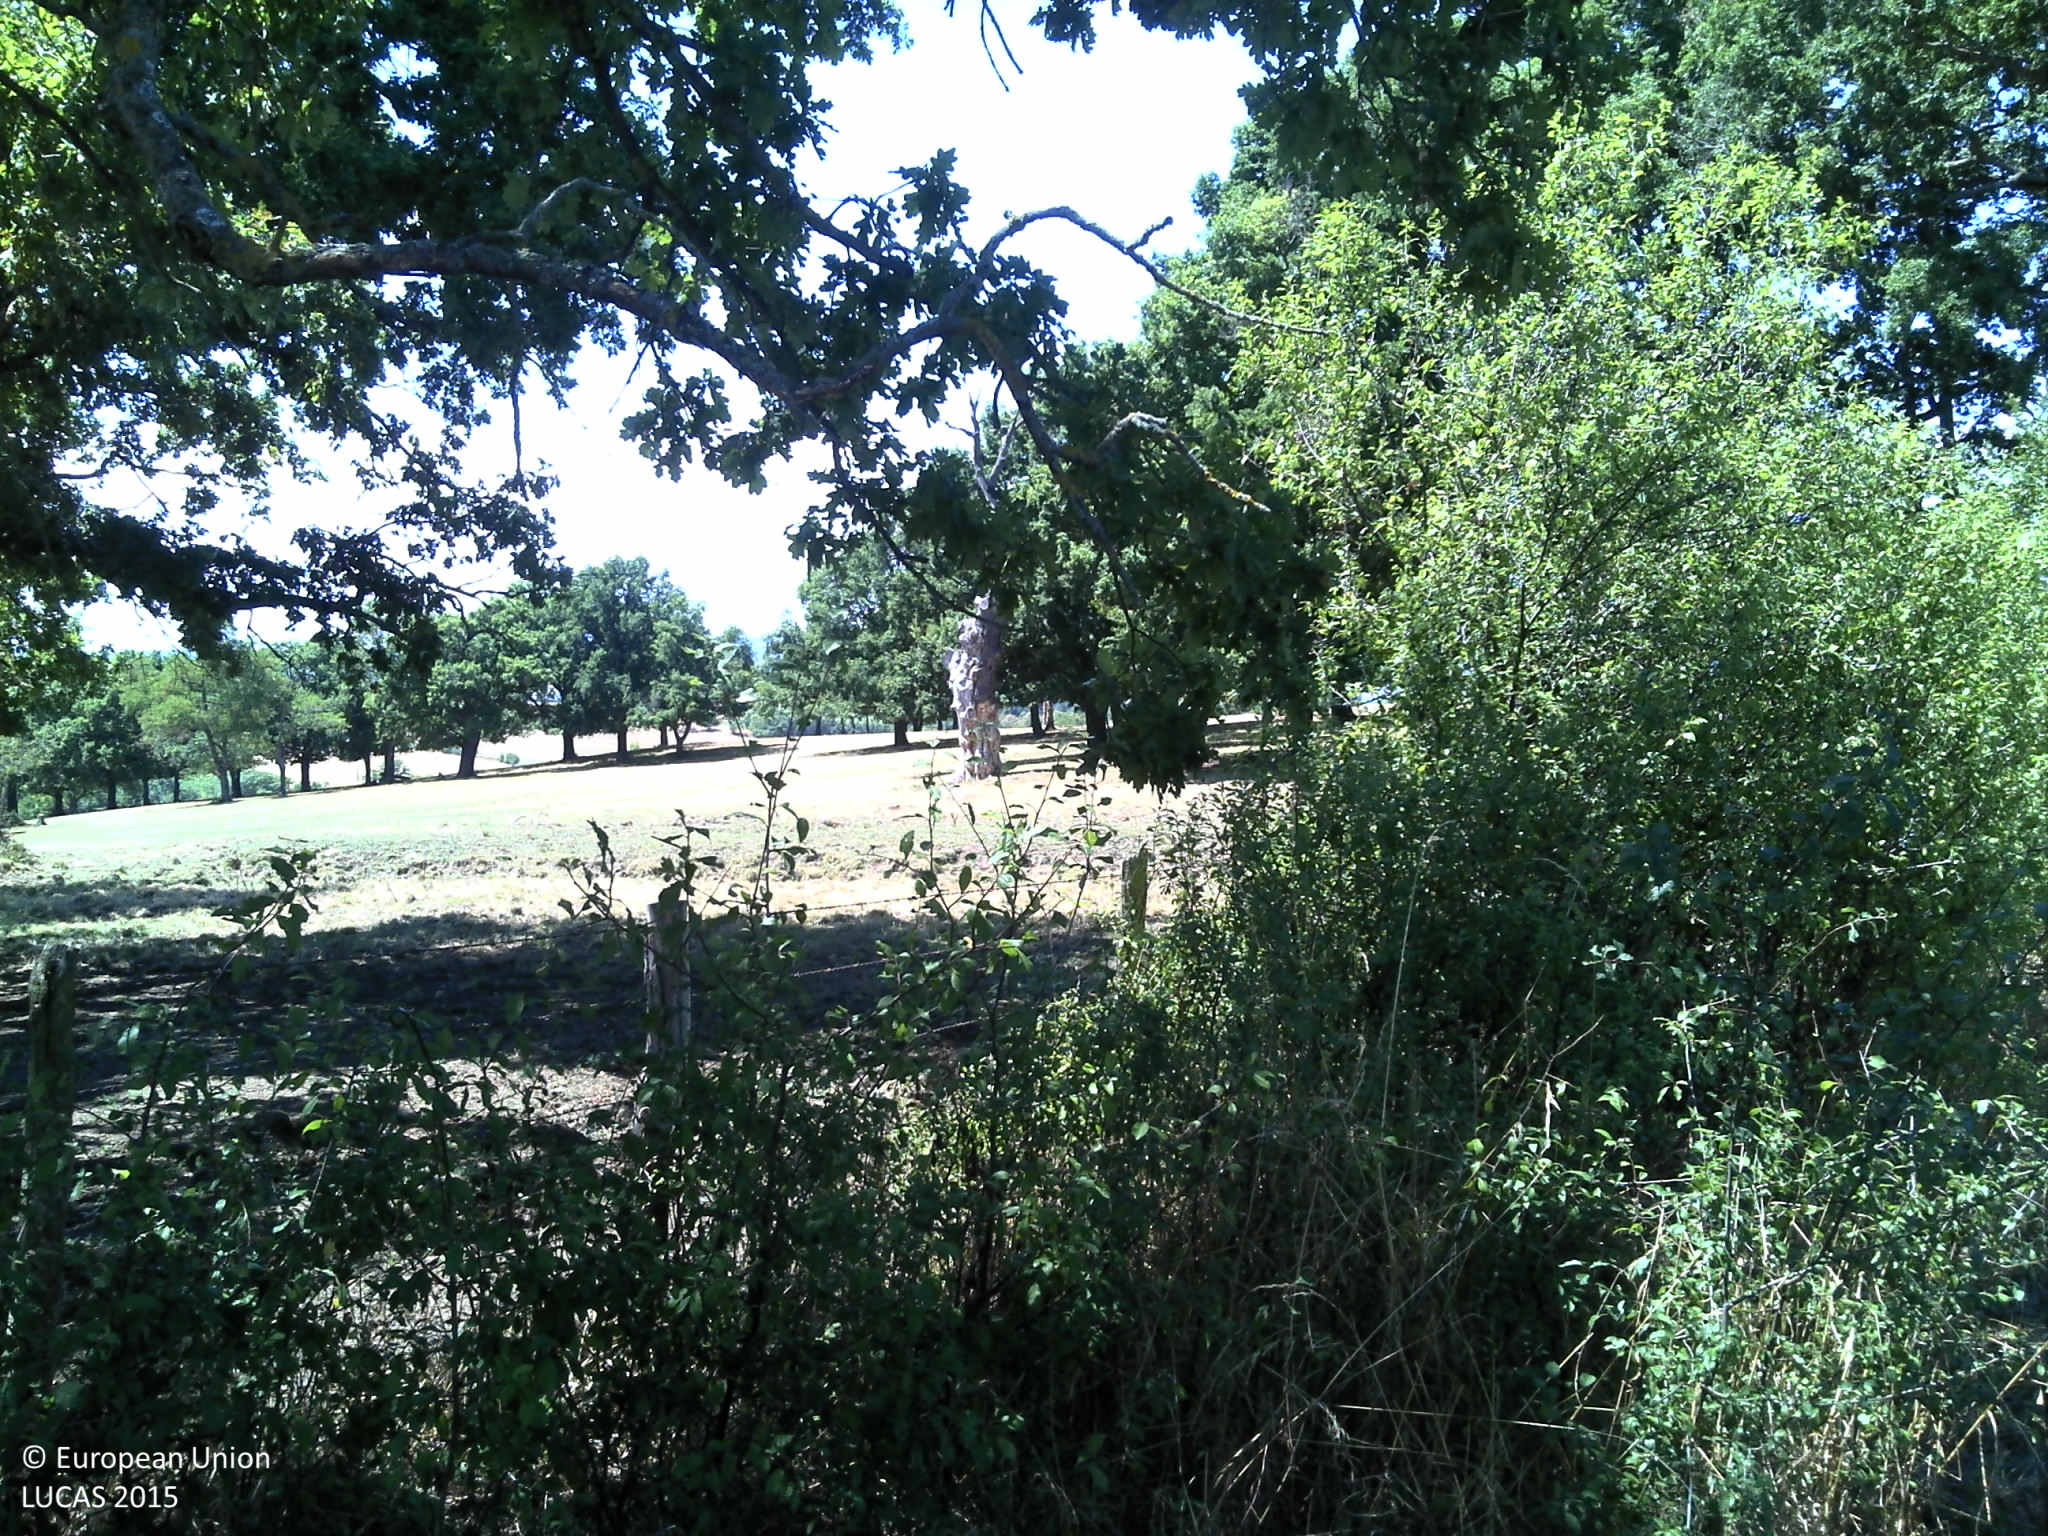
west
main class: Grassland
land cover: Grassland without tree/shrub cover
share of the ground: > 75 %
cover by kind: herbaceous plants 100 %
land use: Agriculture (excluding fallow land and kitchen gardens)
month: July
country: FR
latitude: 45.9704
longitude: 4.0782
